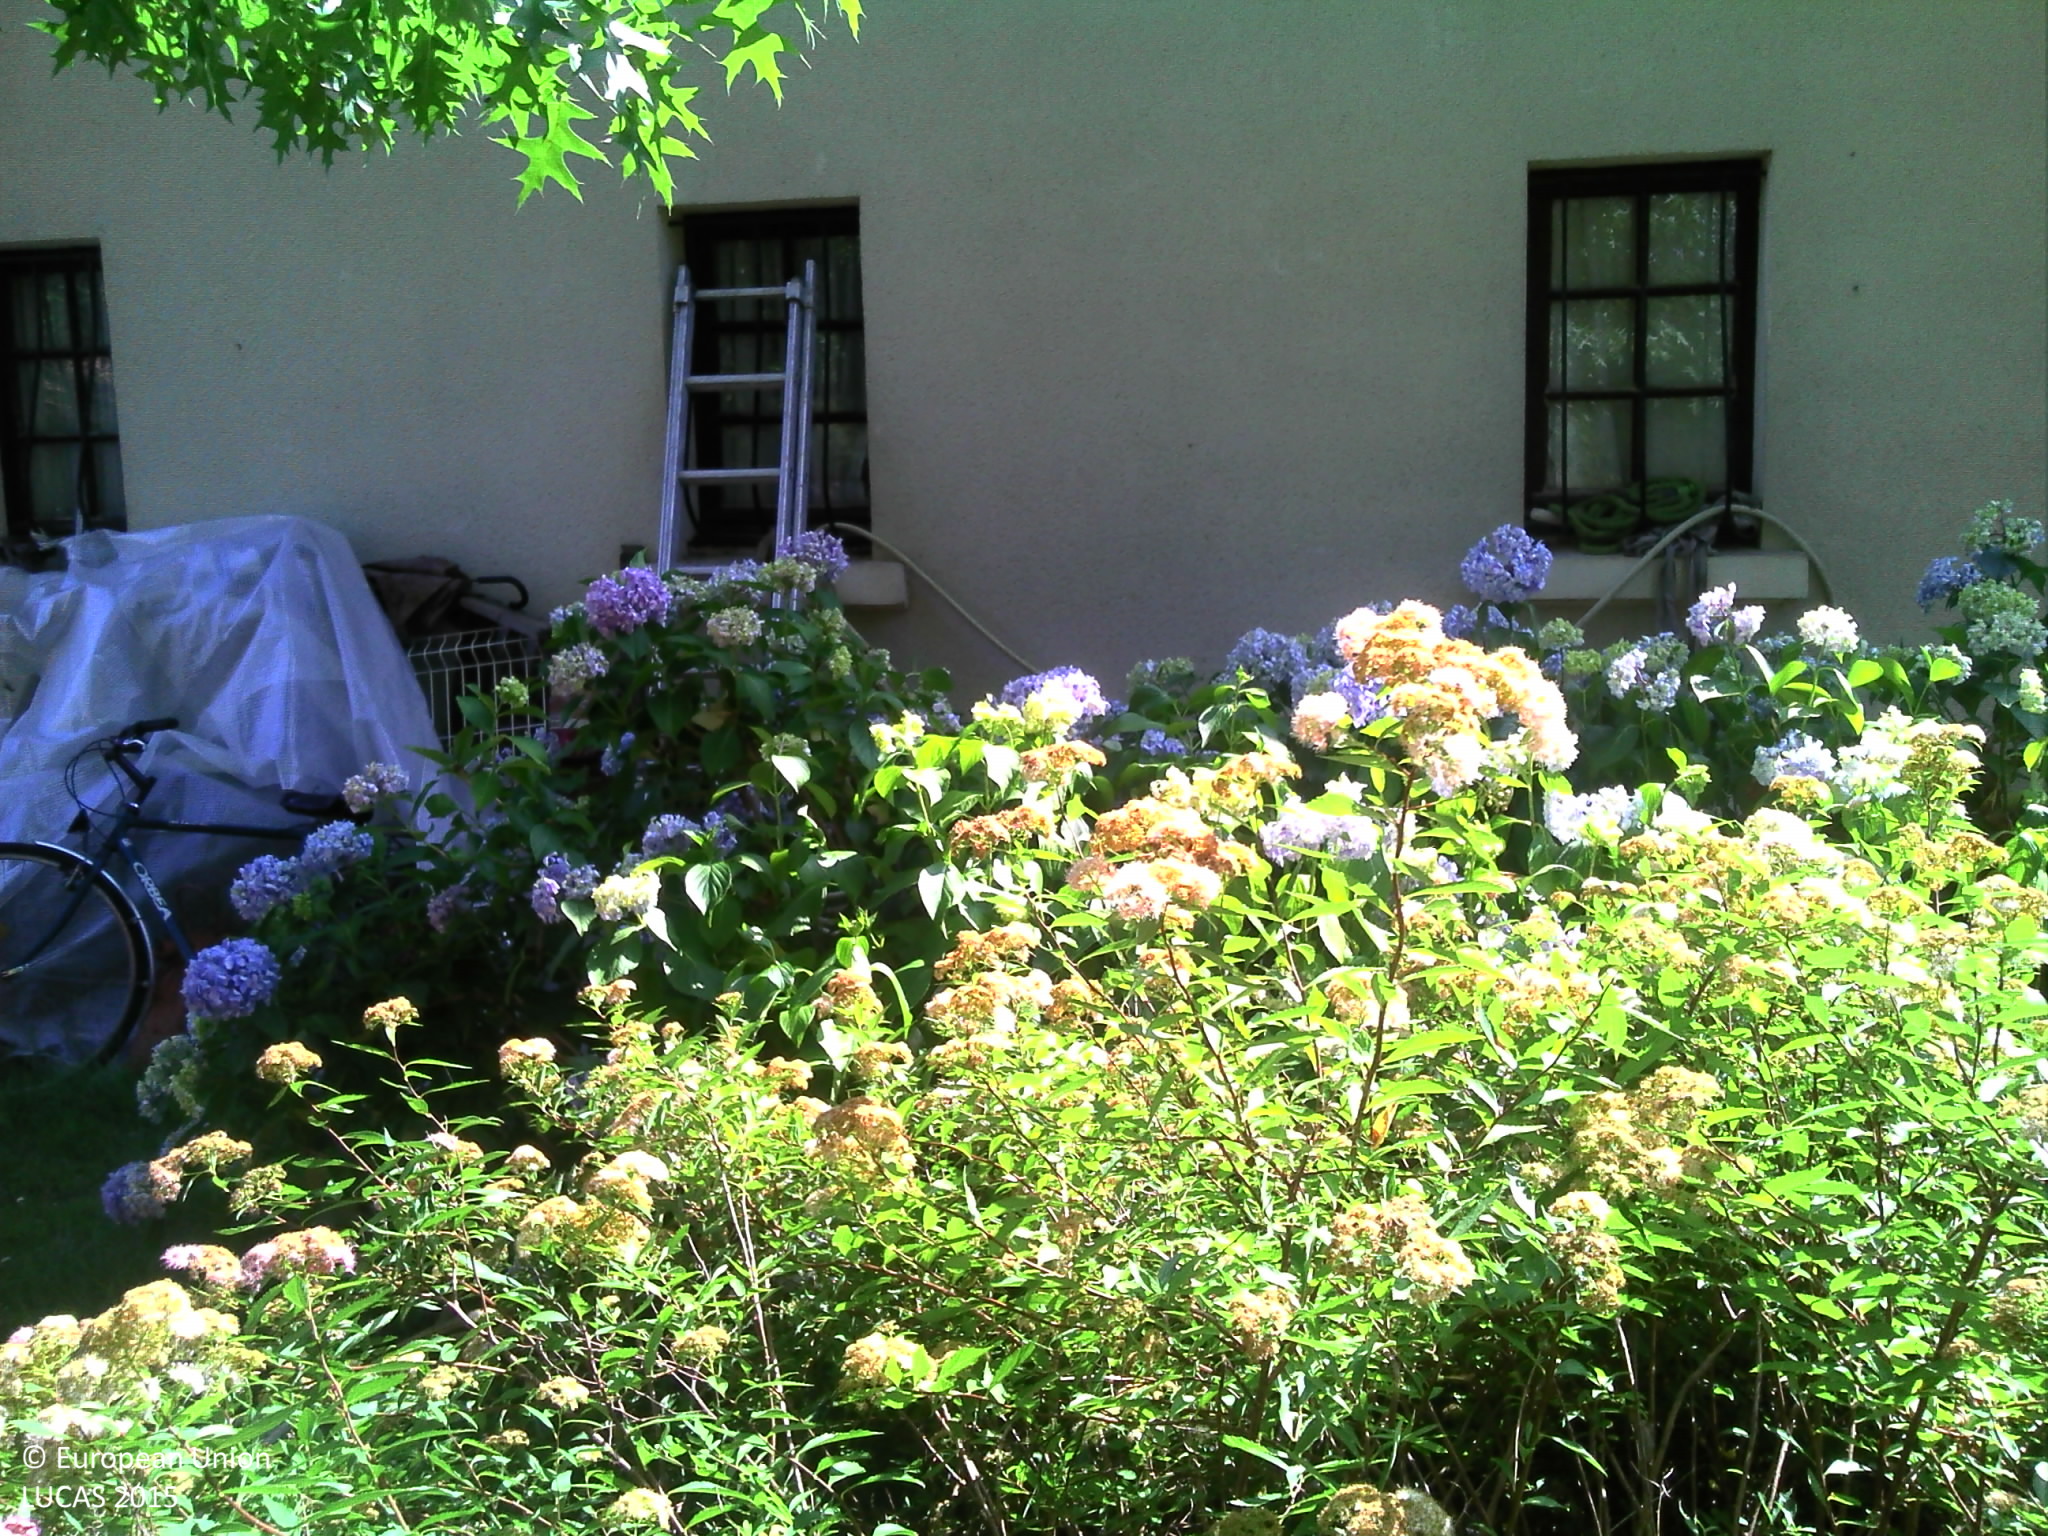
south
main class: Grassland
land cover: Grassland with sparse tree/shrub cover
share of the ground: > 75 %
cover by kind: herbaceous plants 95 %, broadleaved forest trees 5 %
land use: Residential
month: June
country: FR
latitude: 43.8351
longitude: -0.4954
